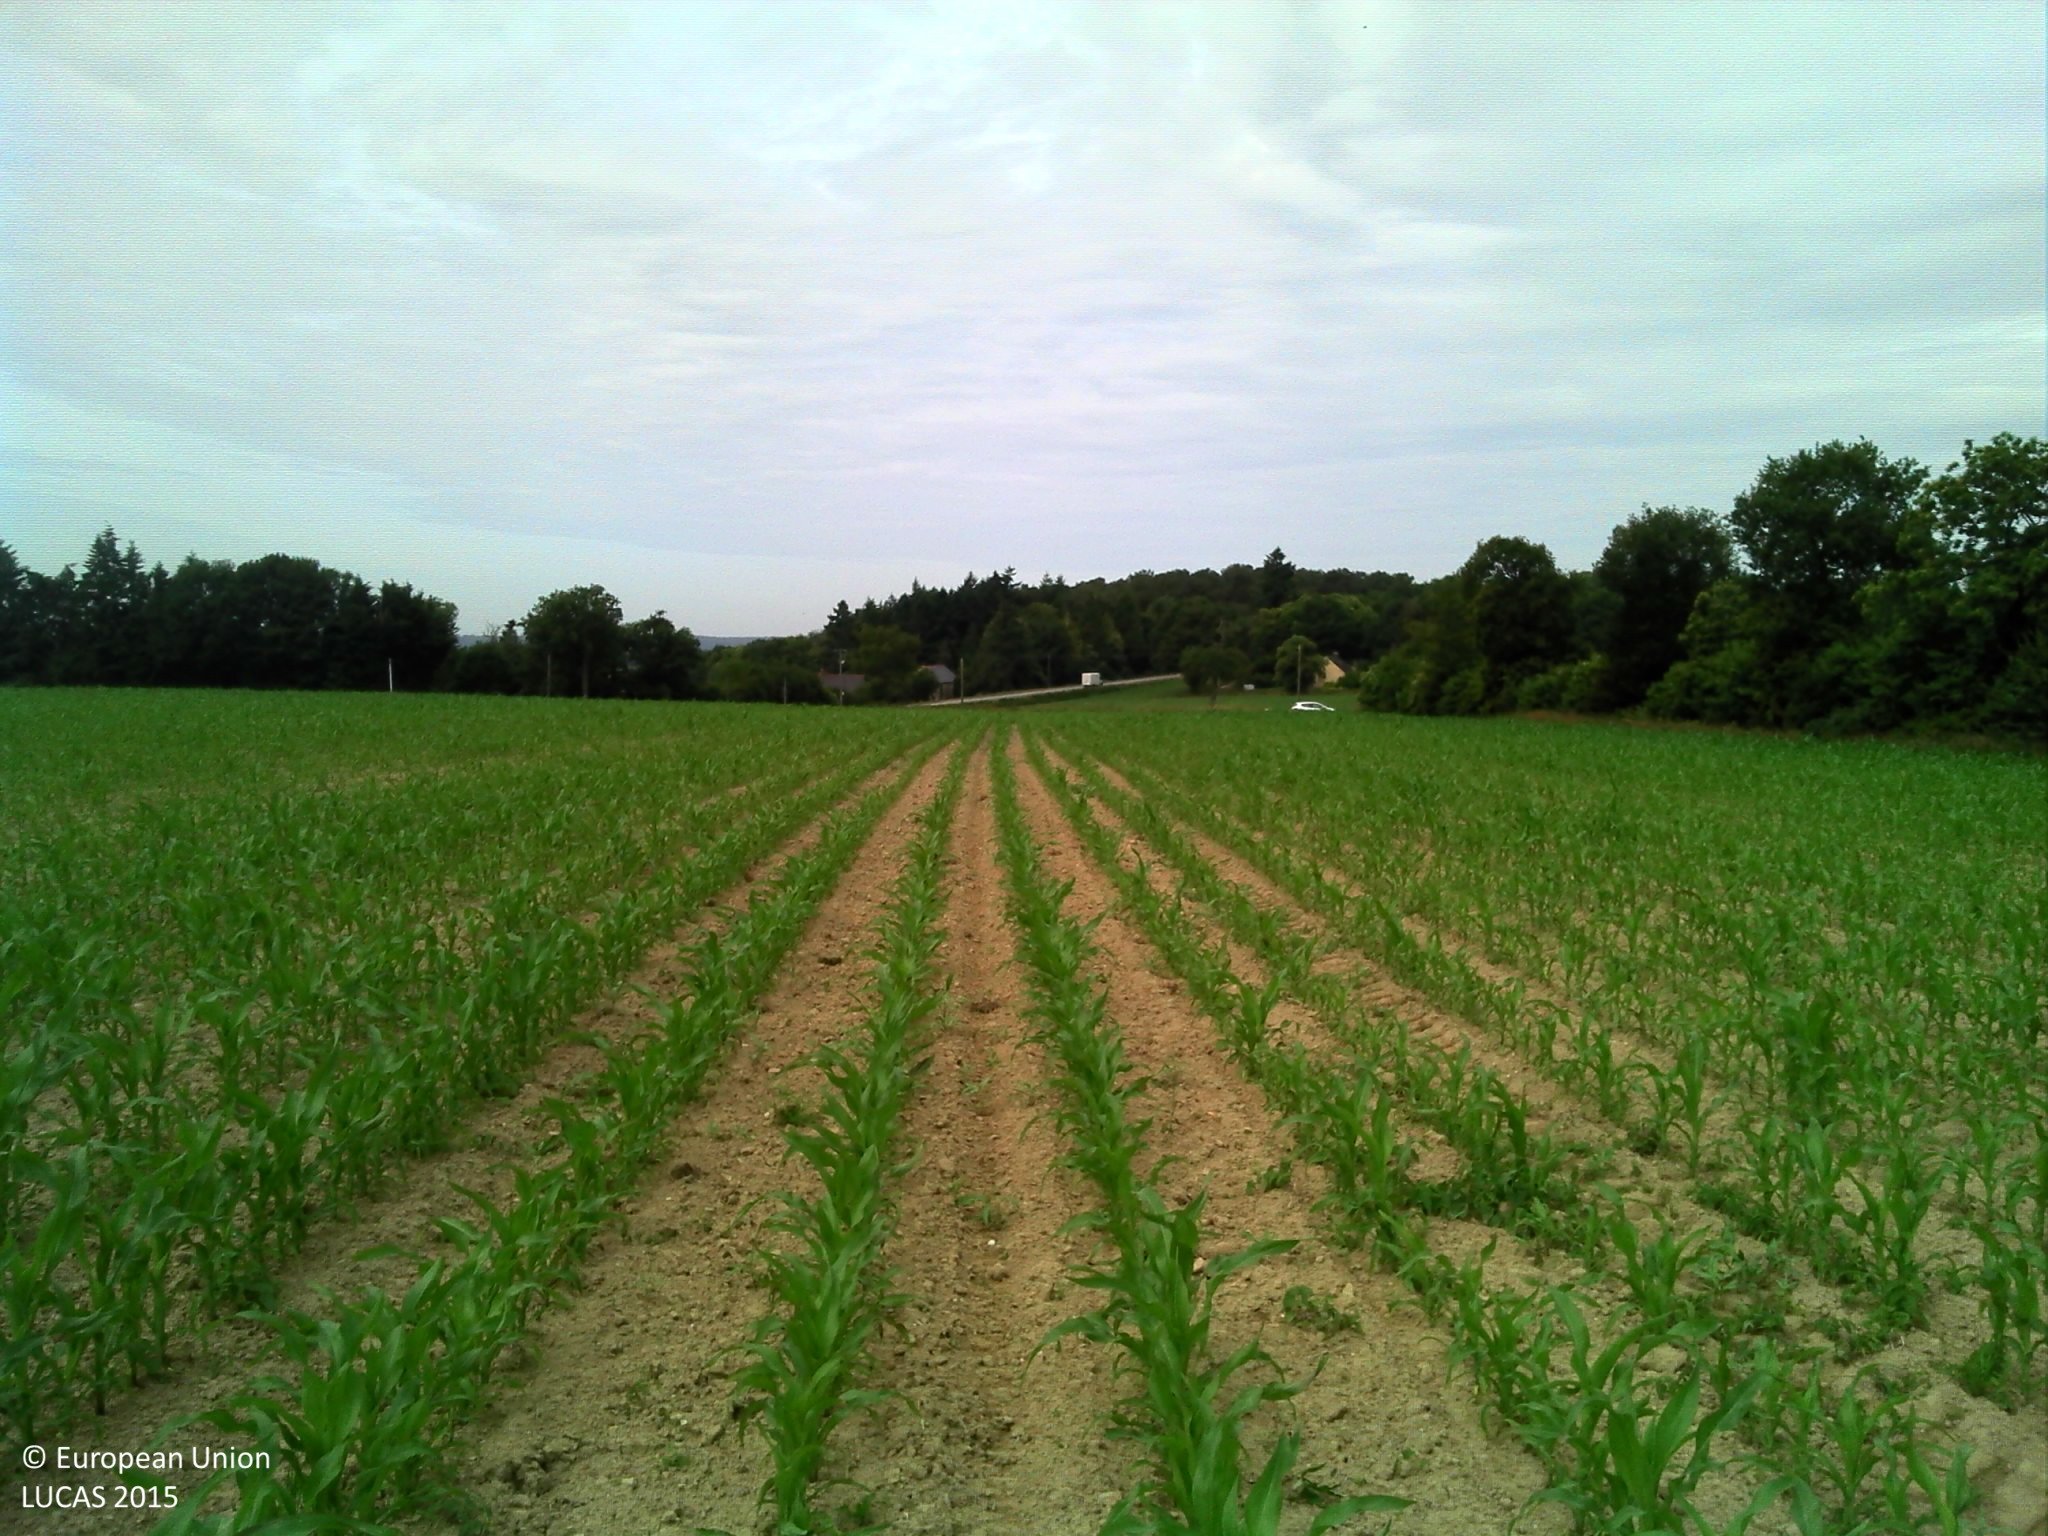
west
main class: Cropland
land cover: Maize
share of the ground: 25 - 50 %
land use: Agriculture (excluding fallow land and kitchen gardens)
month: June
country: FR
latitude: 47.9249
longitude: -1.7043
